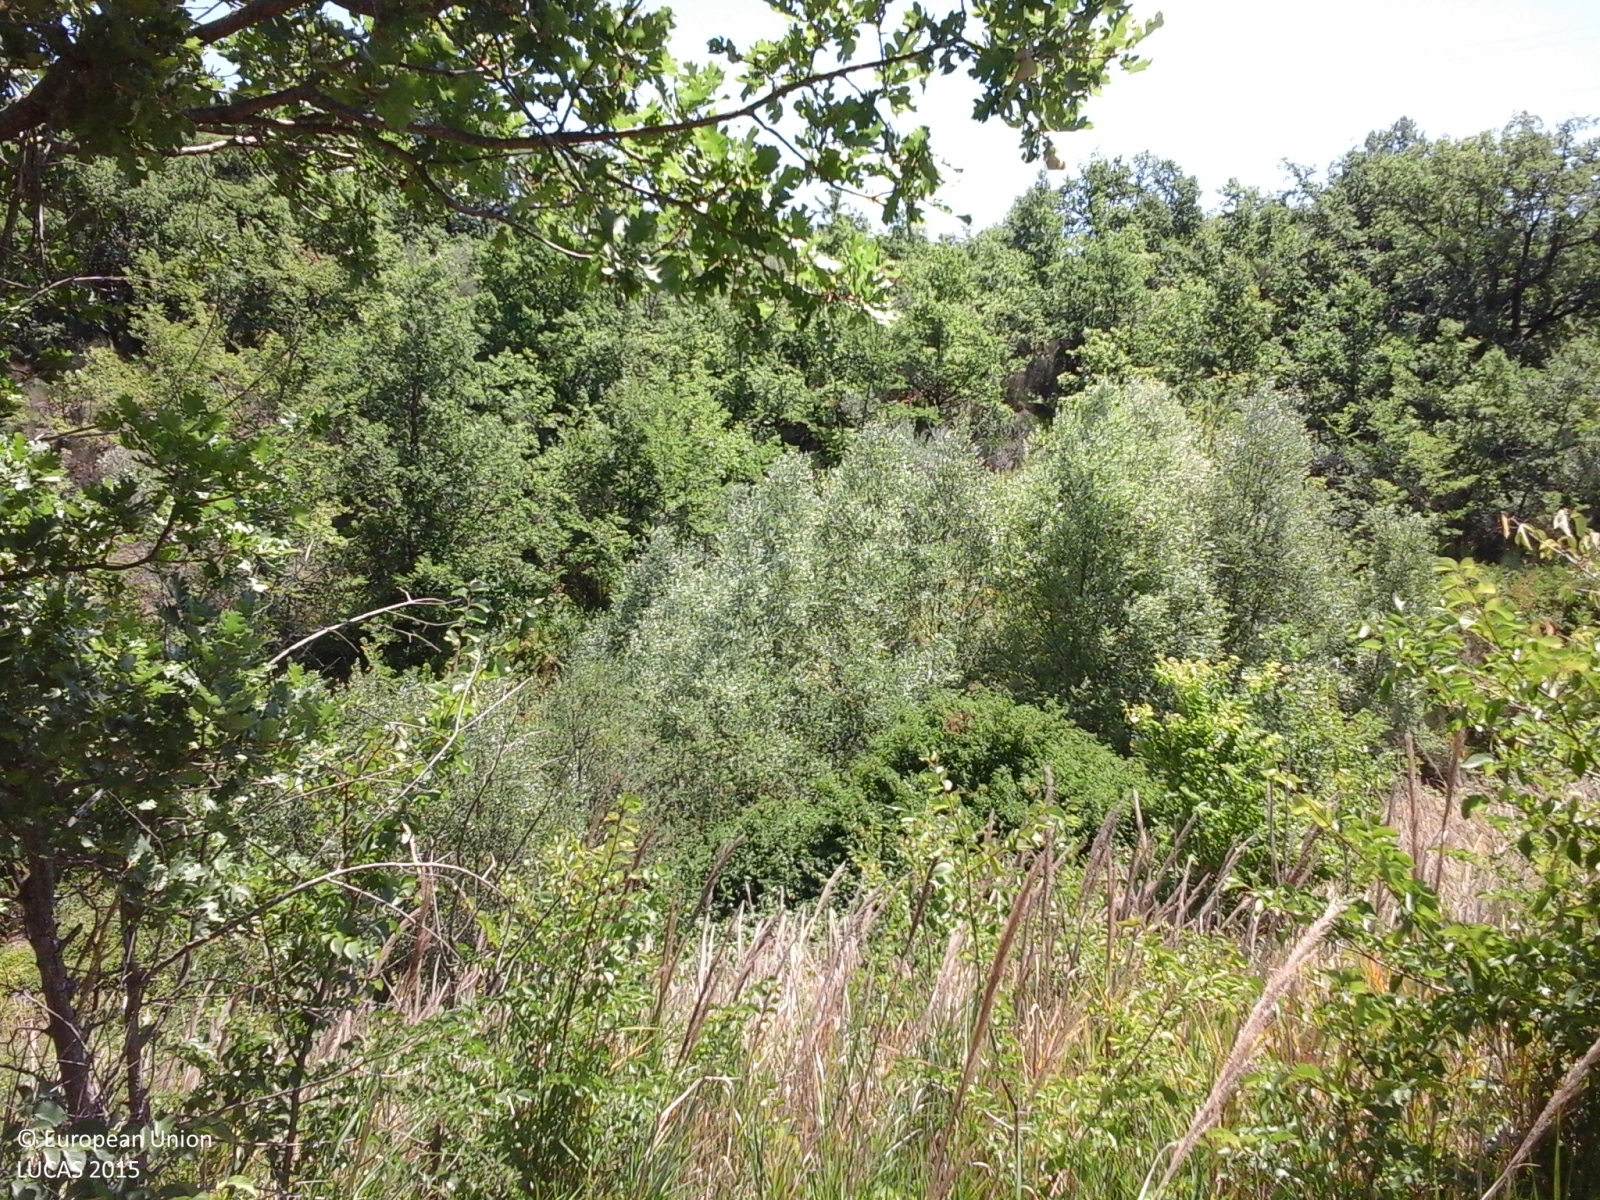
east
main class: Woodland
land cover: Broadleaved woodland
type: thermophilous deciduous forest
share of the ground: > 75 %
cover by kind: broadleaved forest trees 75 %, shrubs 15 %, herbaceous plants 10 %
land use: Semi-natural and natural areas not in use
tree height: > 5 m
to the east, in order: Broadleaved woodland; Electric lines; Shrubland with sparse tree cover; Tracks; Olive groves; Oats; Dry pulses
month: July
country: IT
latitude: 41.7111
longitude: 14.7315
